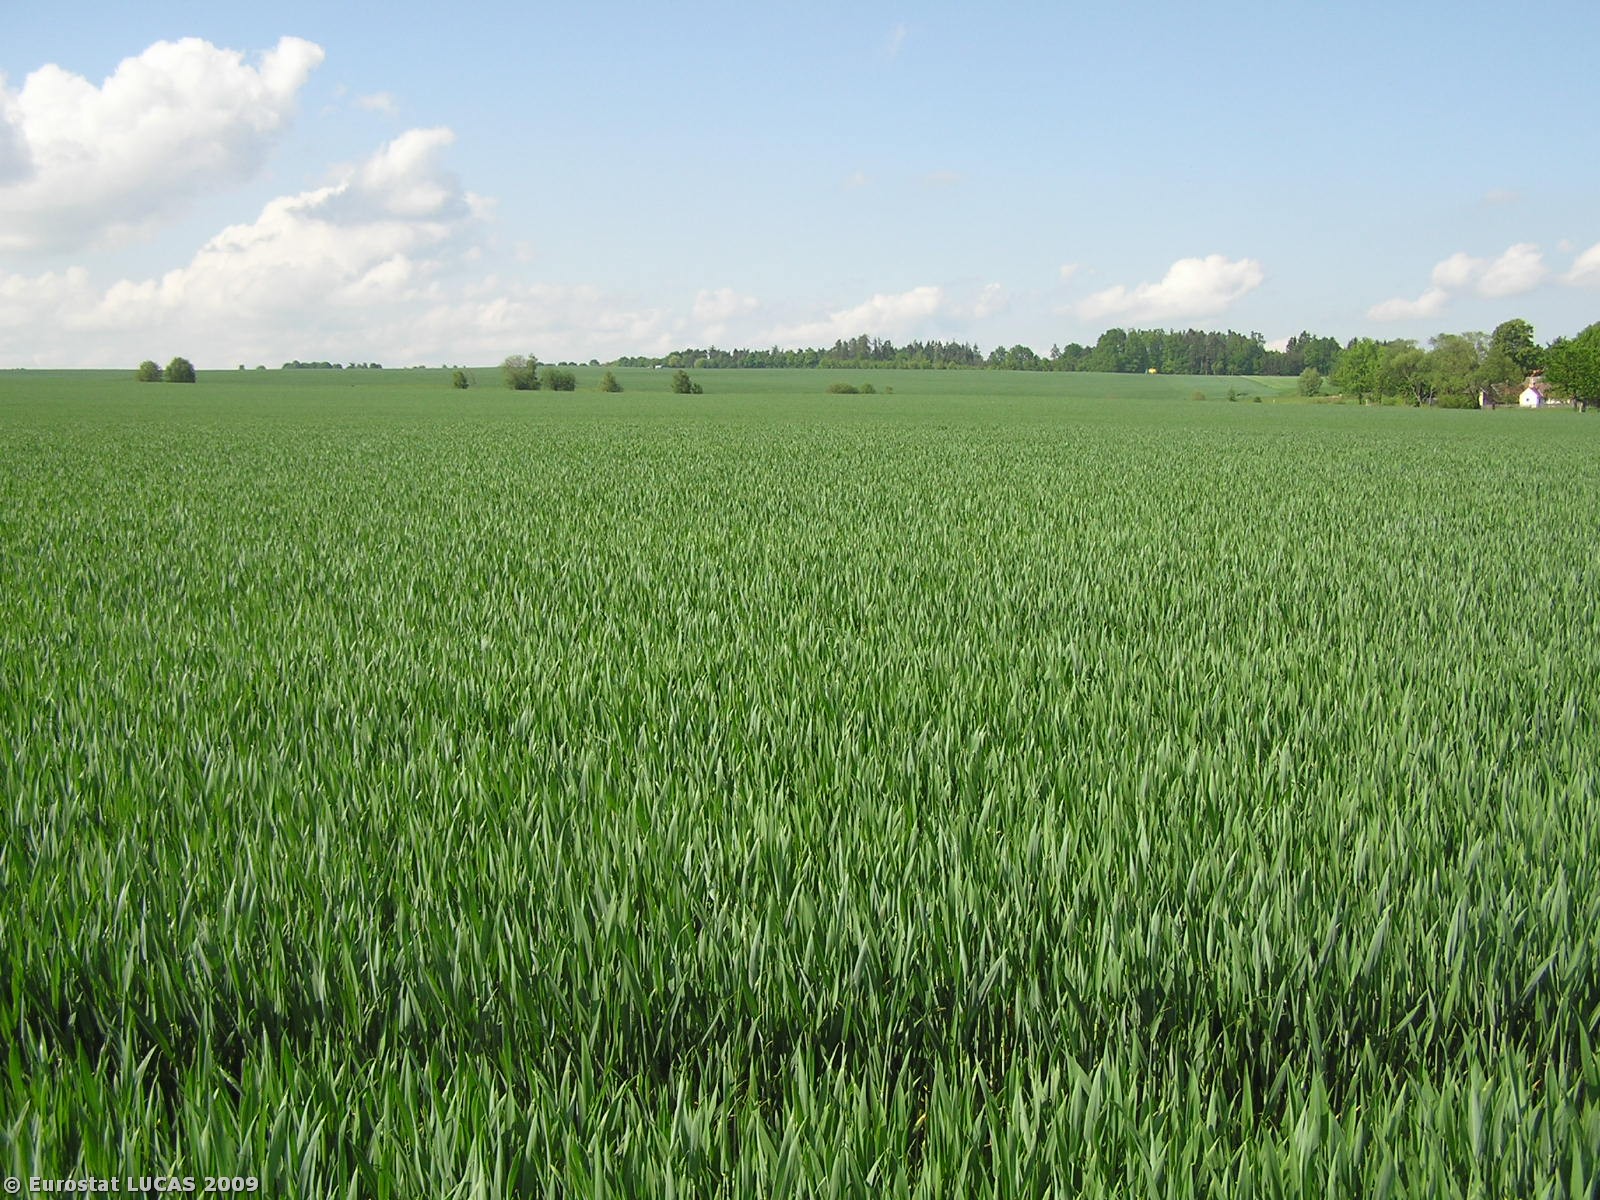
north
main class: Cropland
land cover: Common wheat
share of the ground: > 75 %
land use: Agriculture (excluding fallow land and kitchen gardens)
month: May
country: CZ
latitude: 49.3176
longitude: 14.5825
